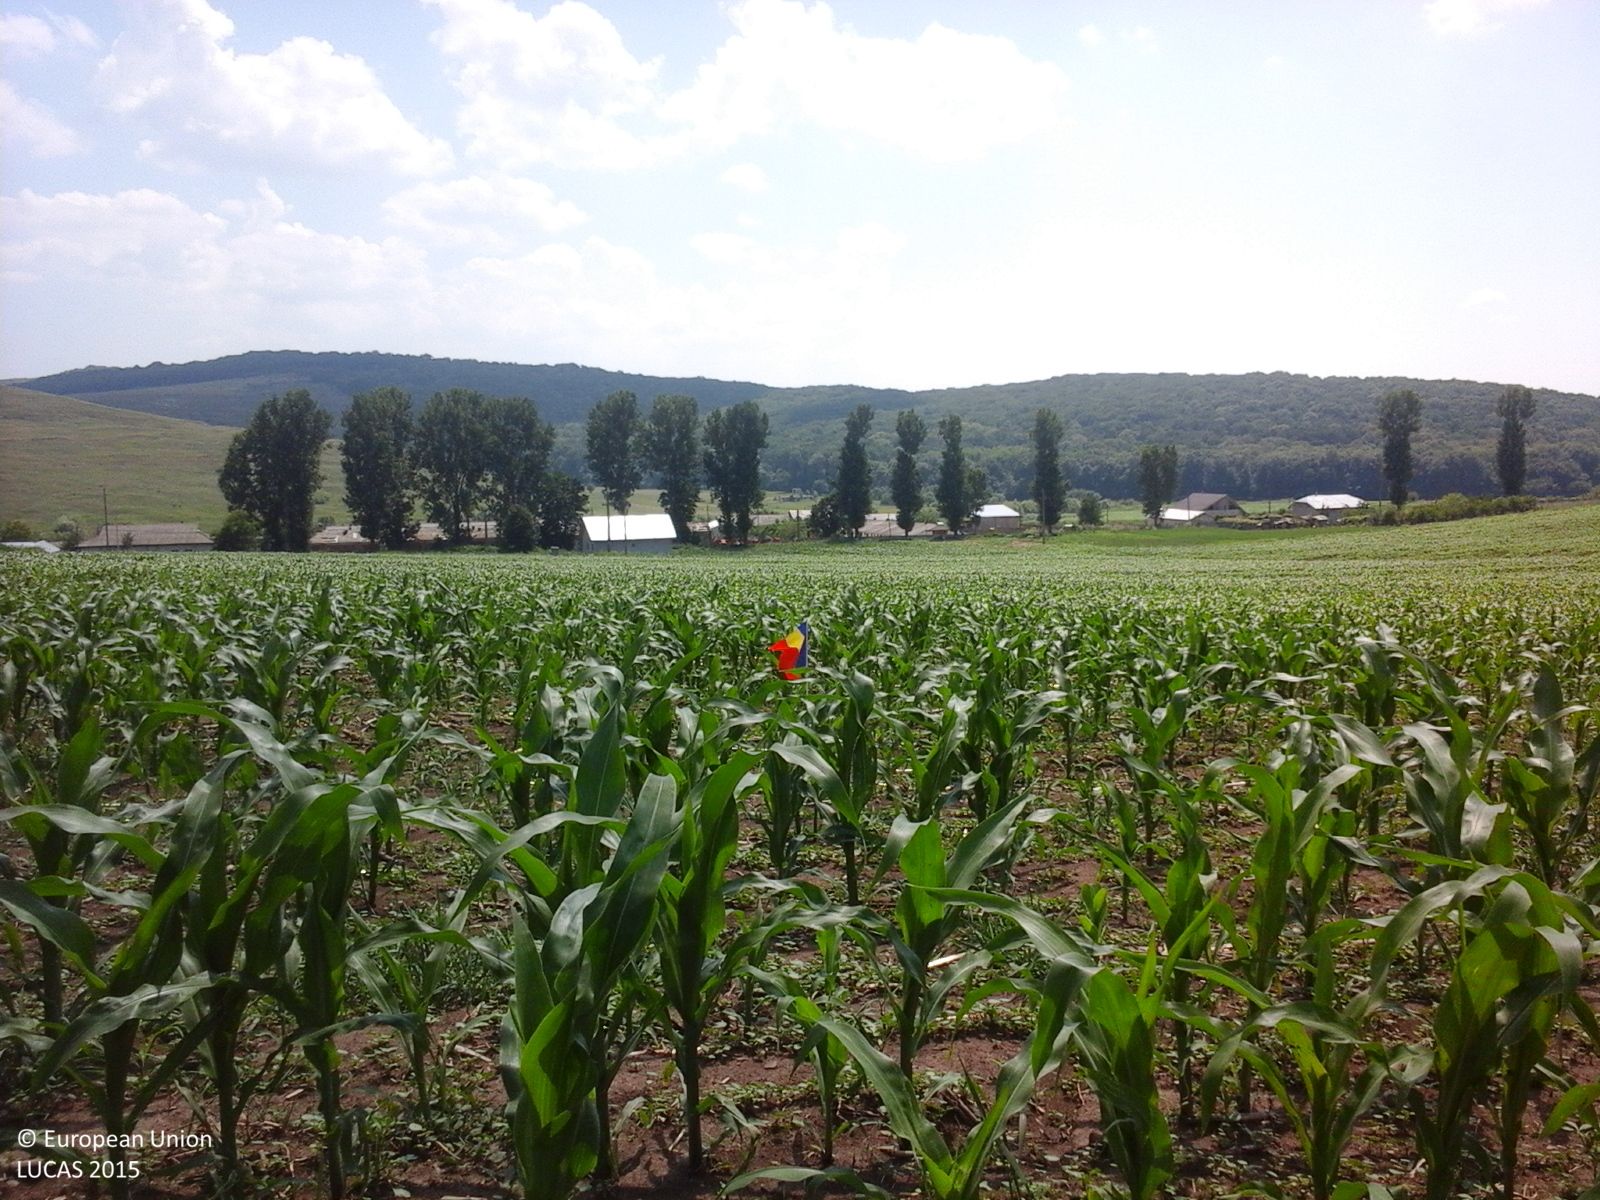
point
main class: Cropland
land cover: Maize
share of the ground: 25 - 50 %
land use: Agriculture (excluding fallow land and kitchen gardens)
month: June
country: RO
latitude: 46.9749
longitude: 27.0446
